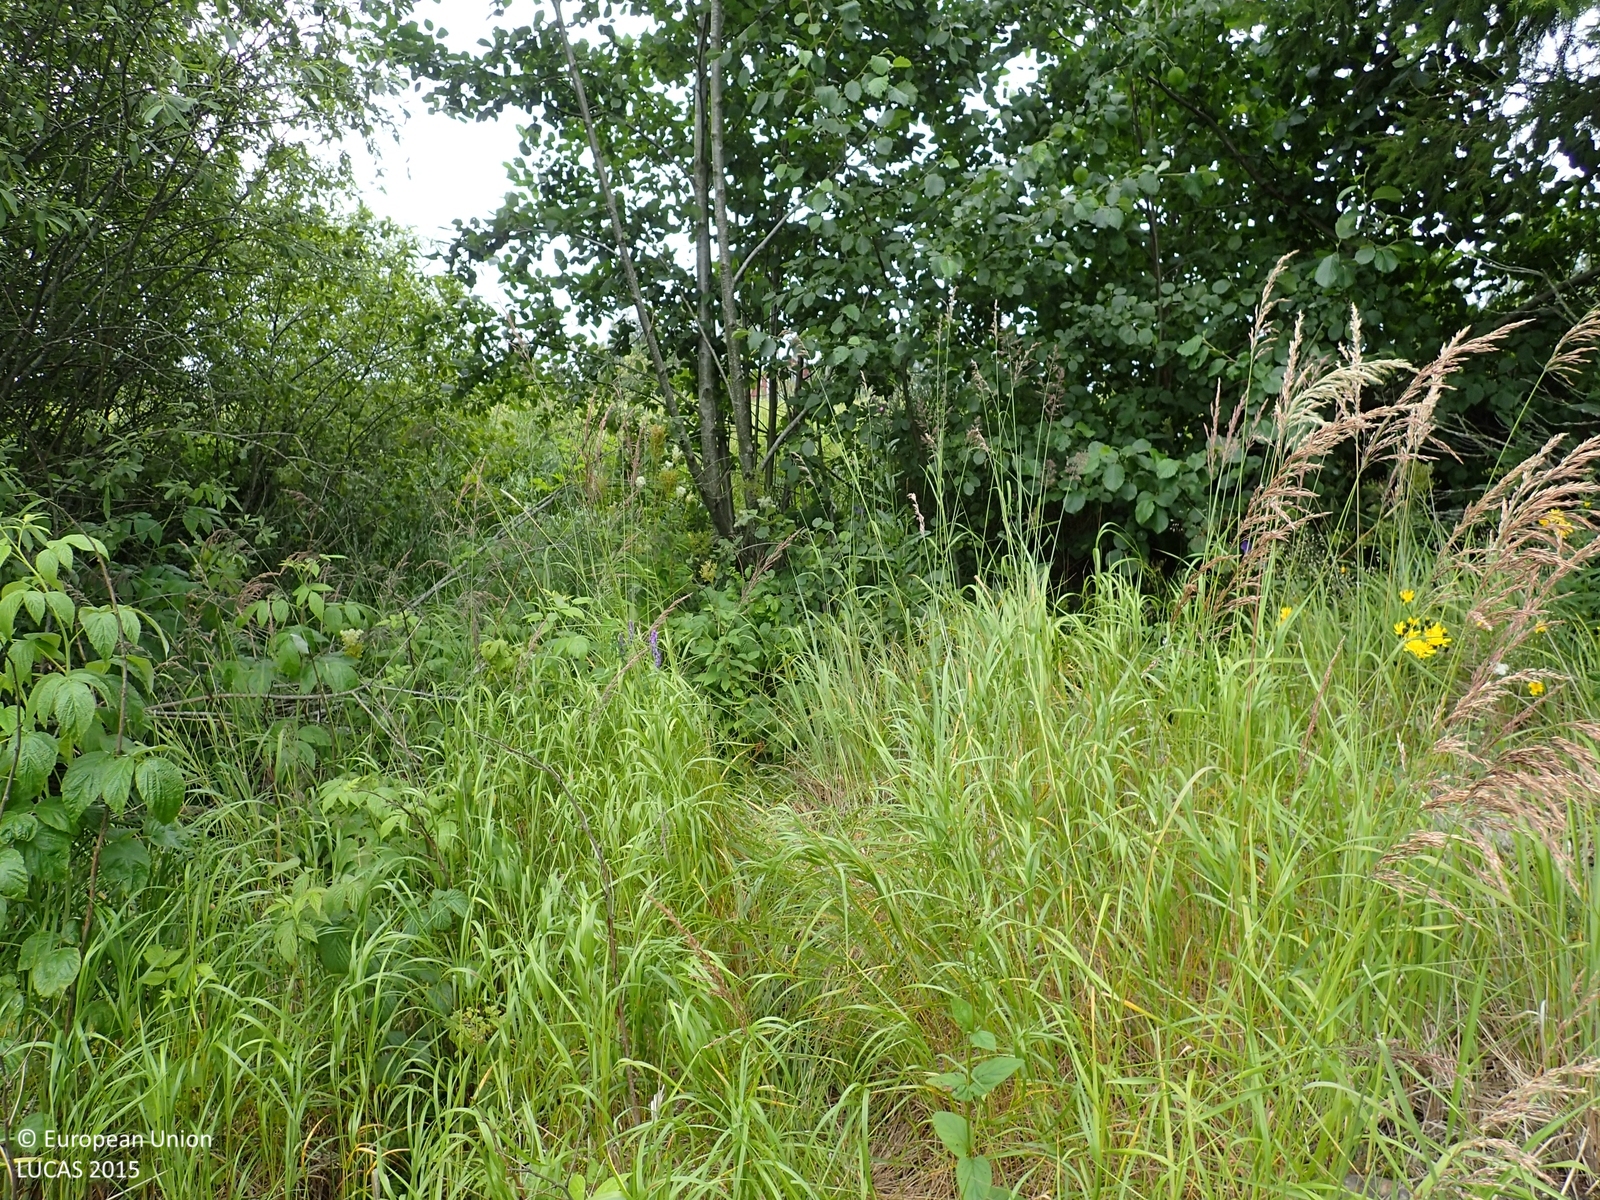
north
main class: Cropland
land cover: Common wheat
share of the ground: > 75 %
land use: Agriculture (excluding fallow land and kitchen gardens)
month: August
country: FI
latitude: 62.9108
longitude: 22.0735
